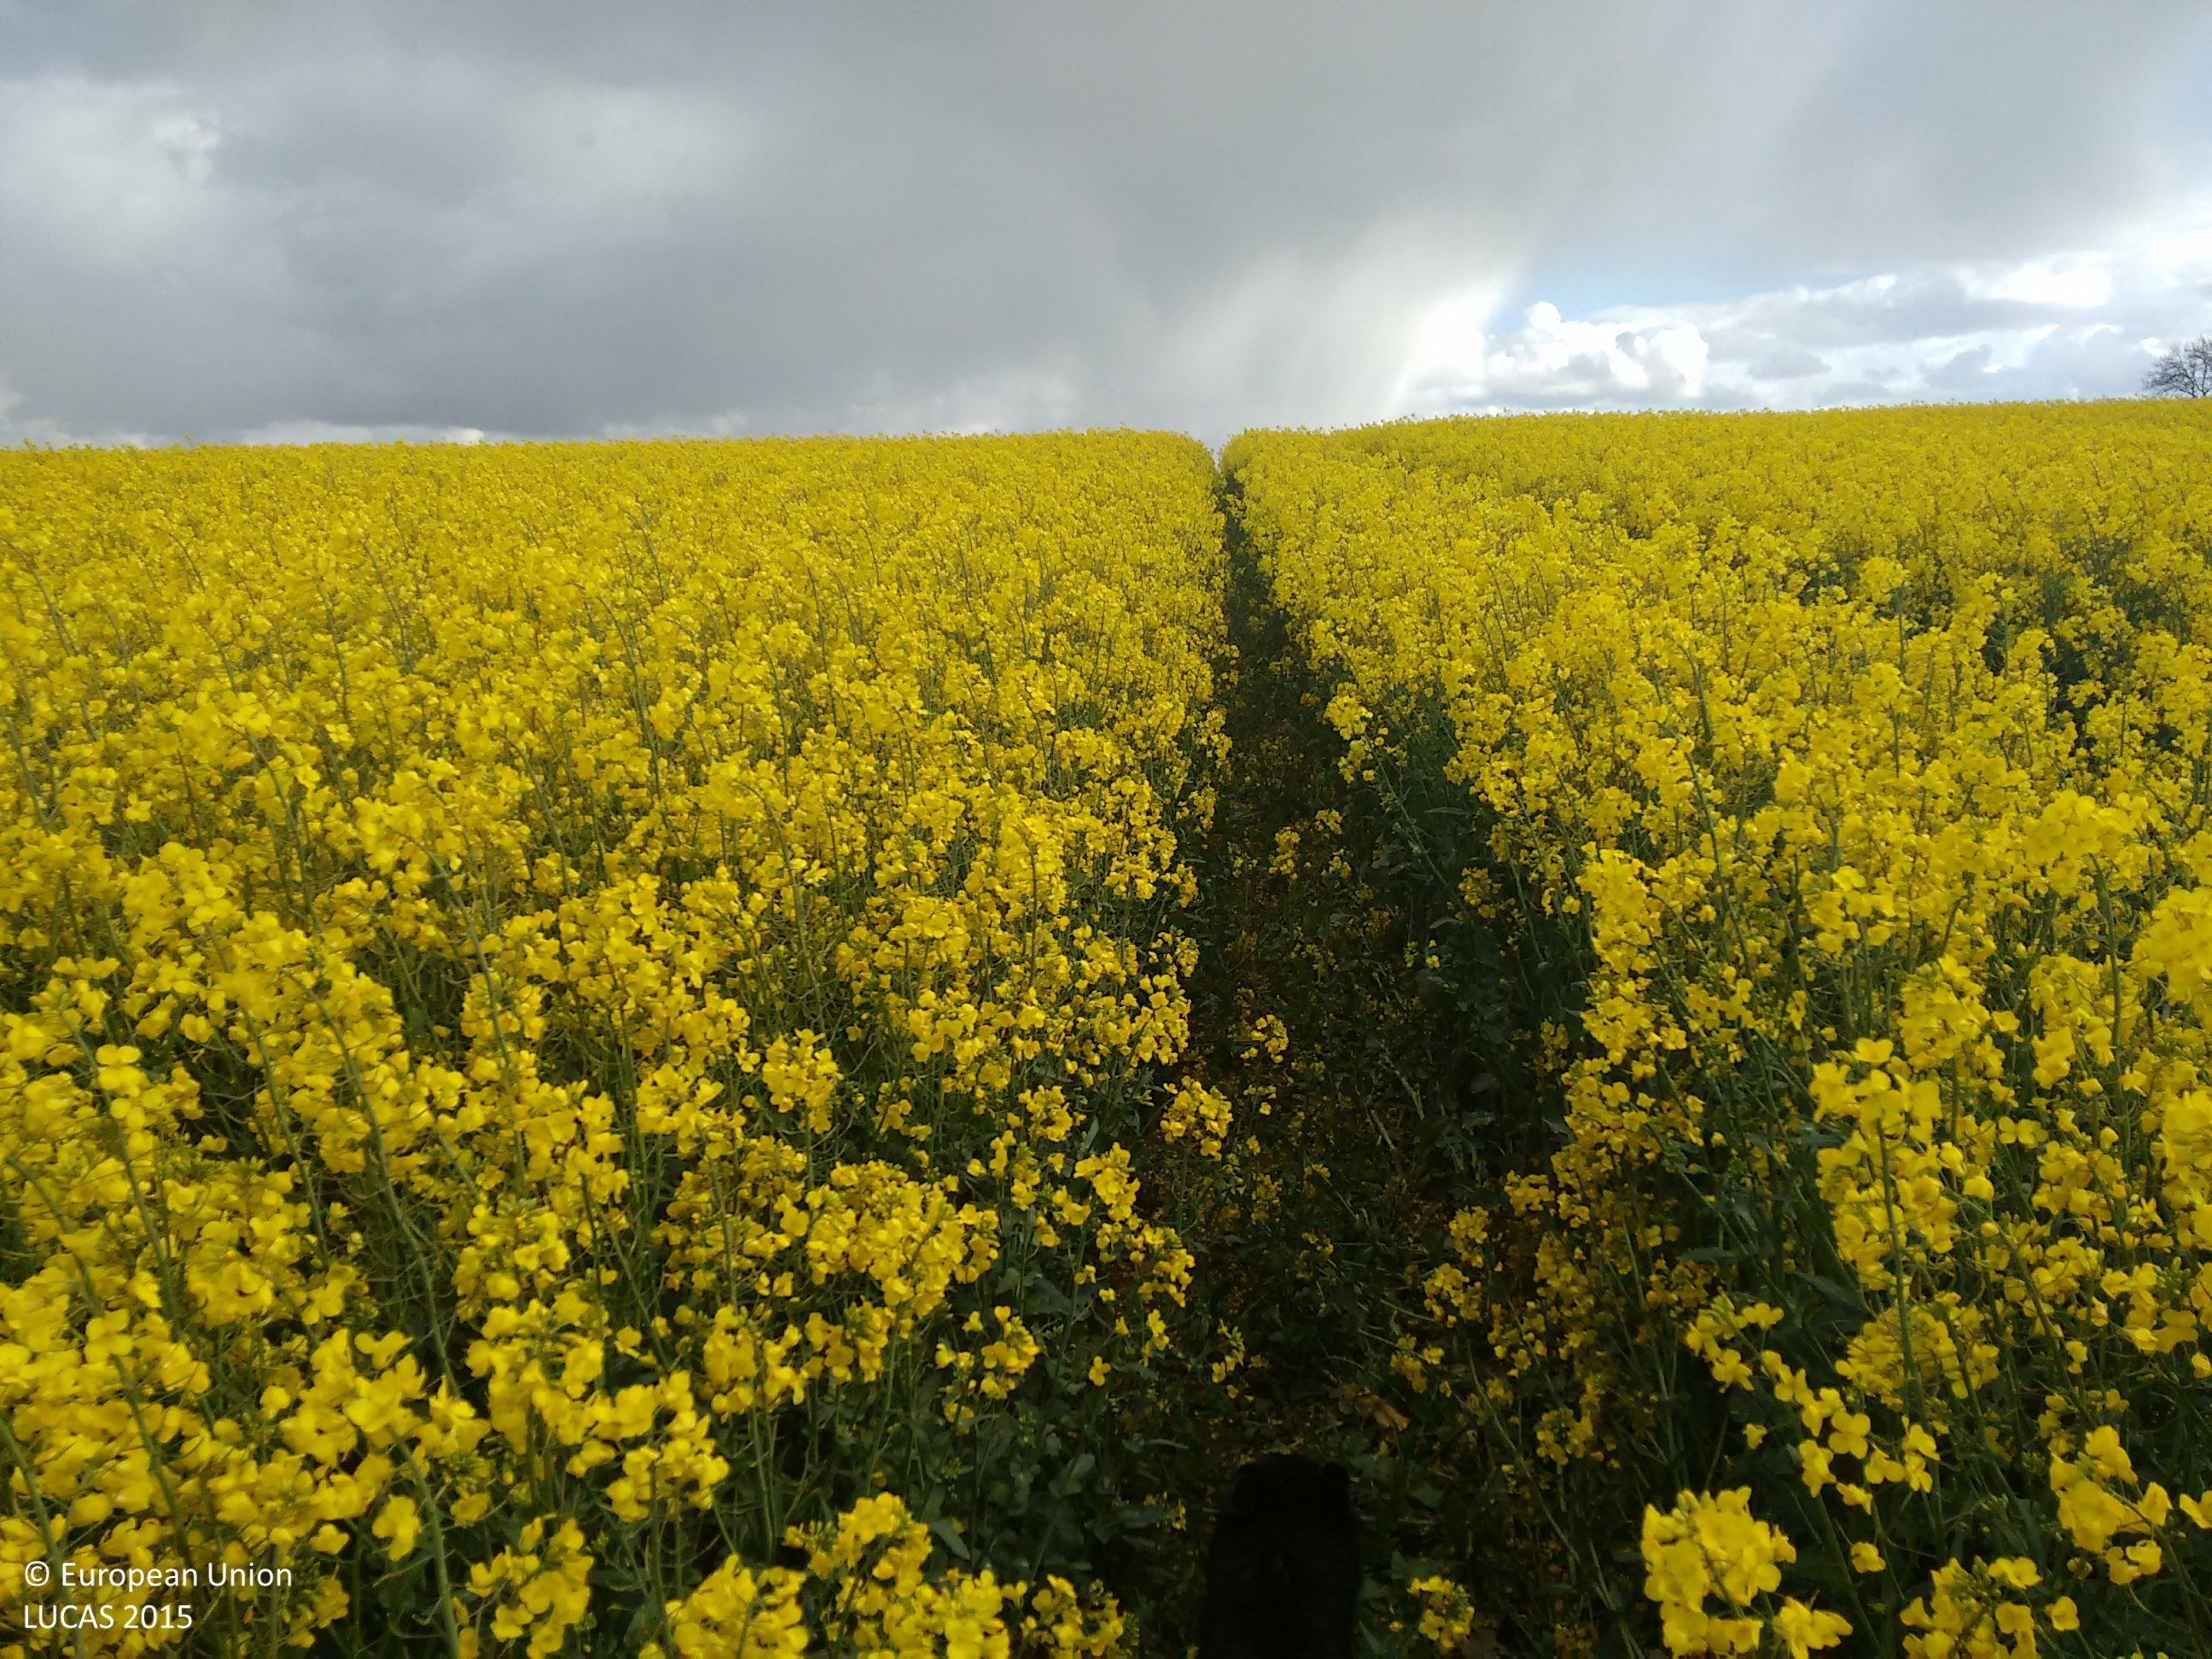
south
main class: Cropland
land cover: Rape and turnip rape
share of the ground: > 75 %
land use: Agriculture (excluding fallow land and kitchen gardens)
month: May
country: GB
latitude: 55.7530
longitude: -2.3420
